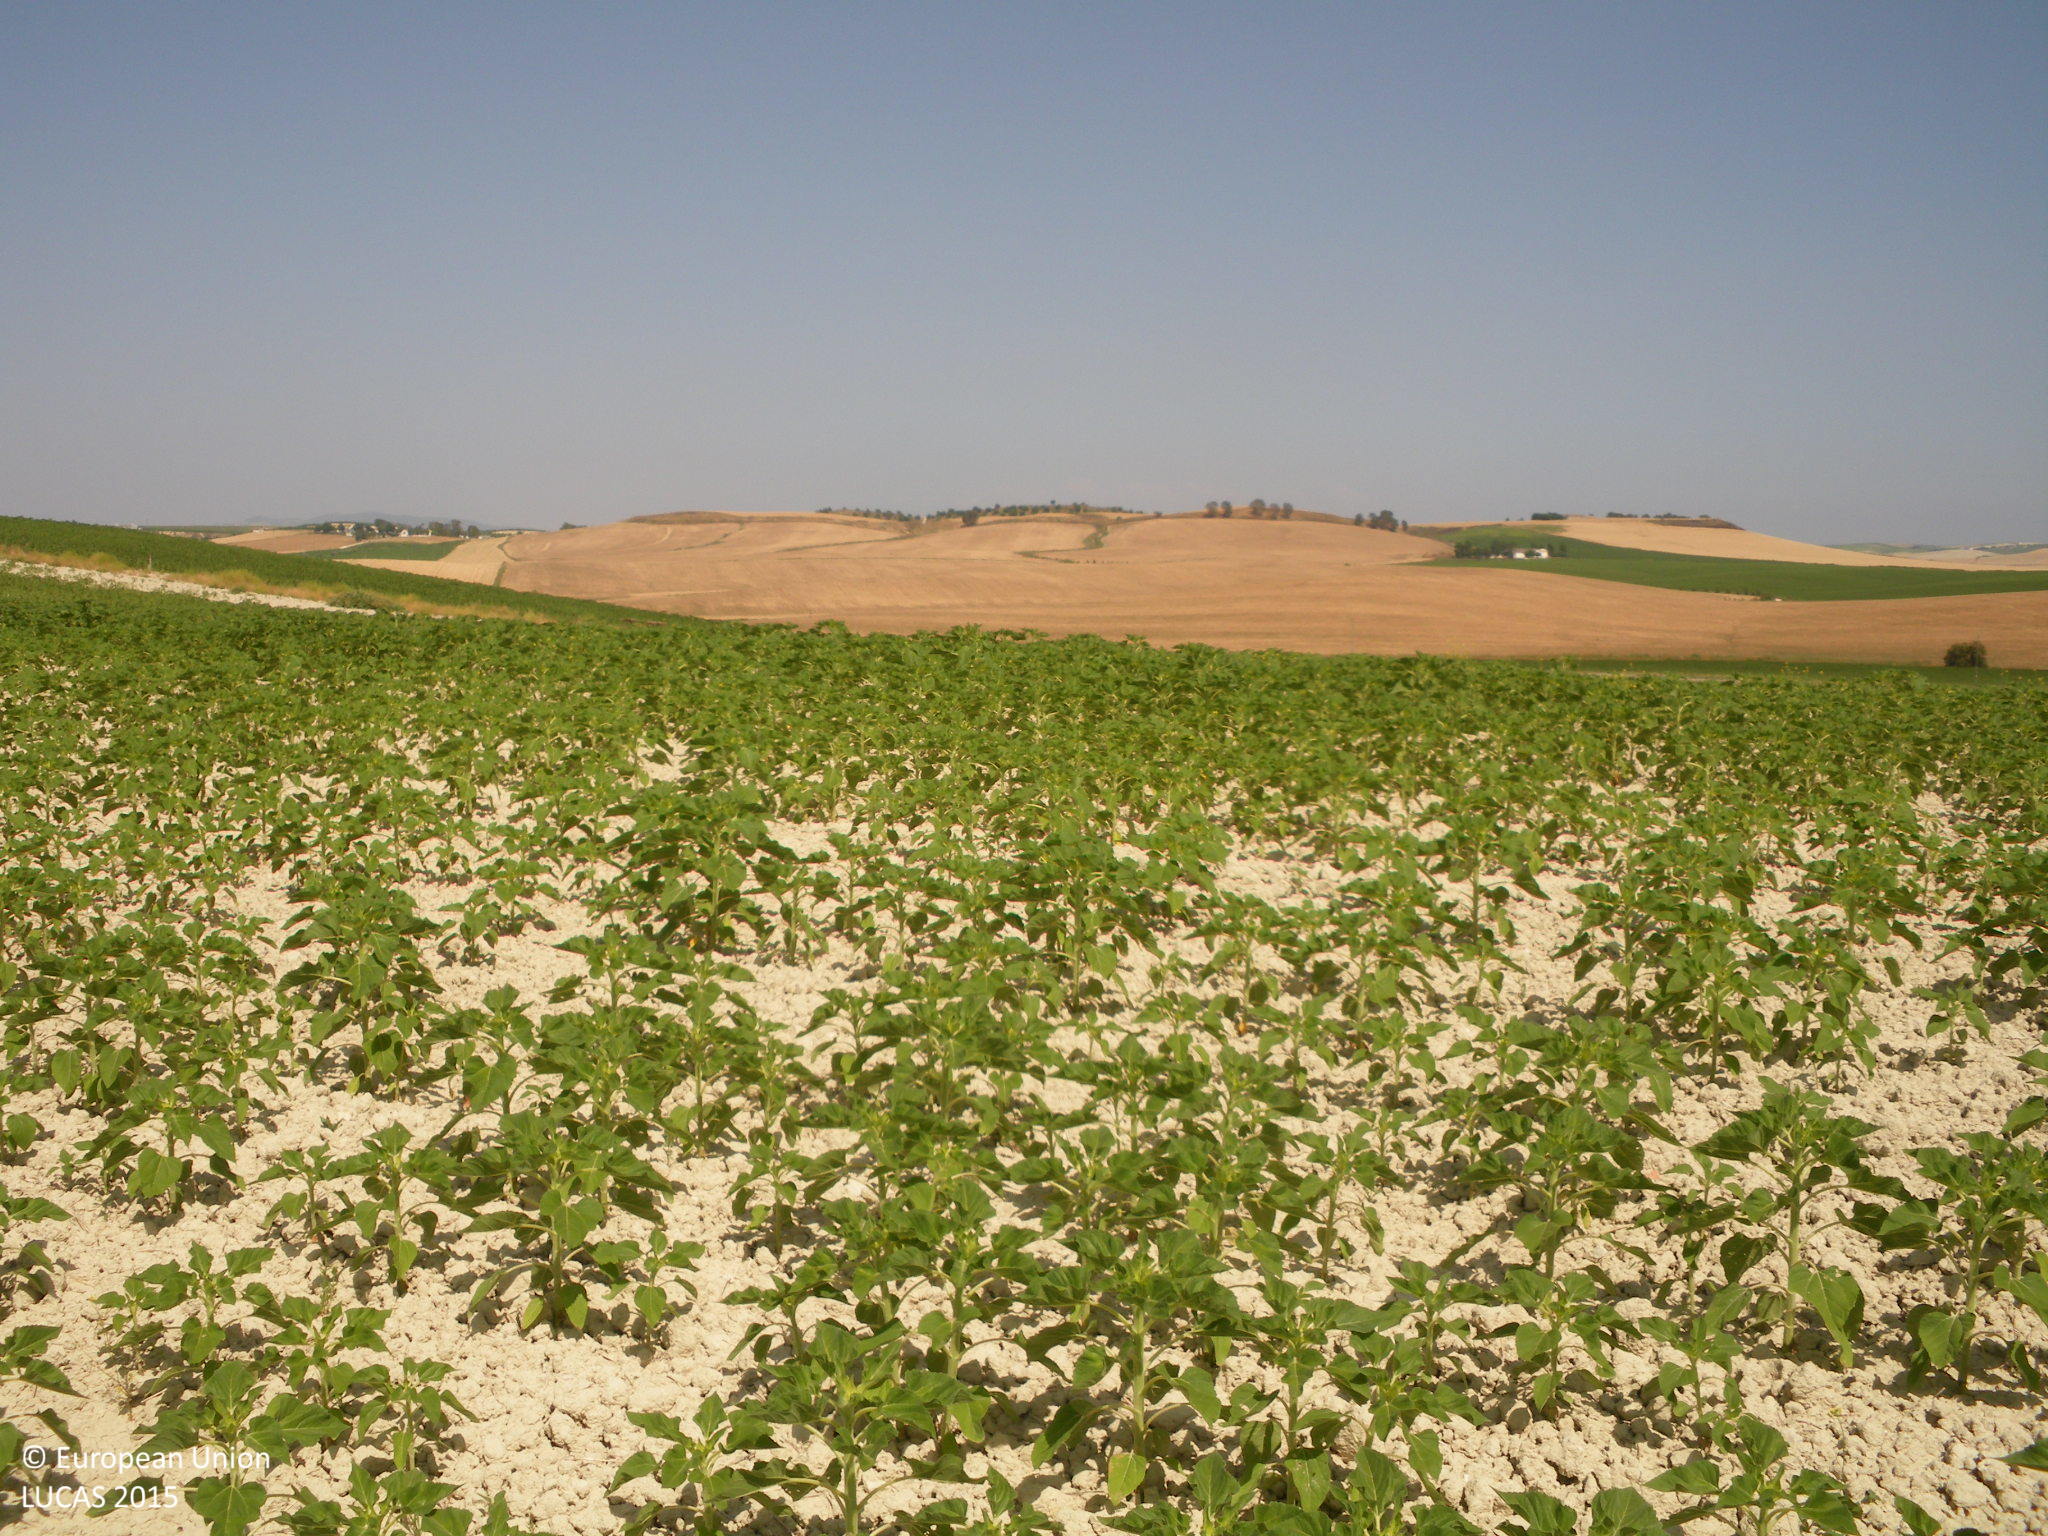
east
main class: Cropland
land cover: Sunflower
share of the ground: 10 - 25 %
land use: Agriculture (excluding fallow land and kitchen gardens)
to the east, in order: Sunflower; Tracks; Grass margins; Sunflower
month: May
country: ES
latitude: 36.7898
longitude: -6.2085
